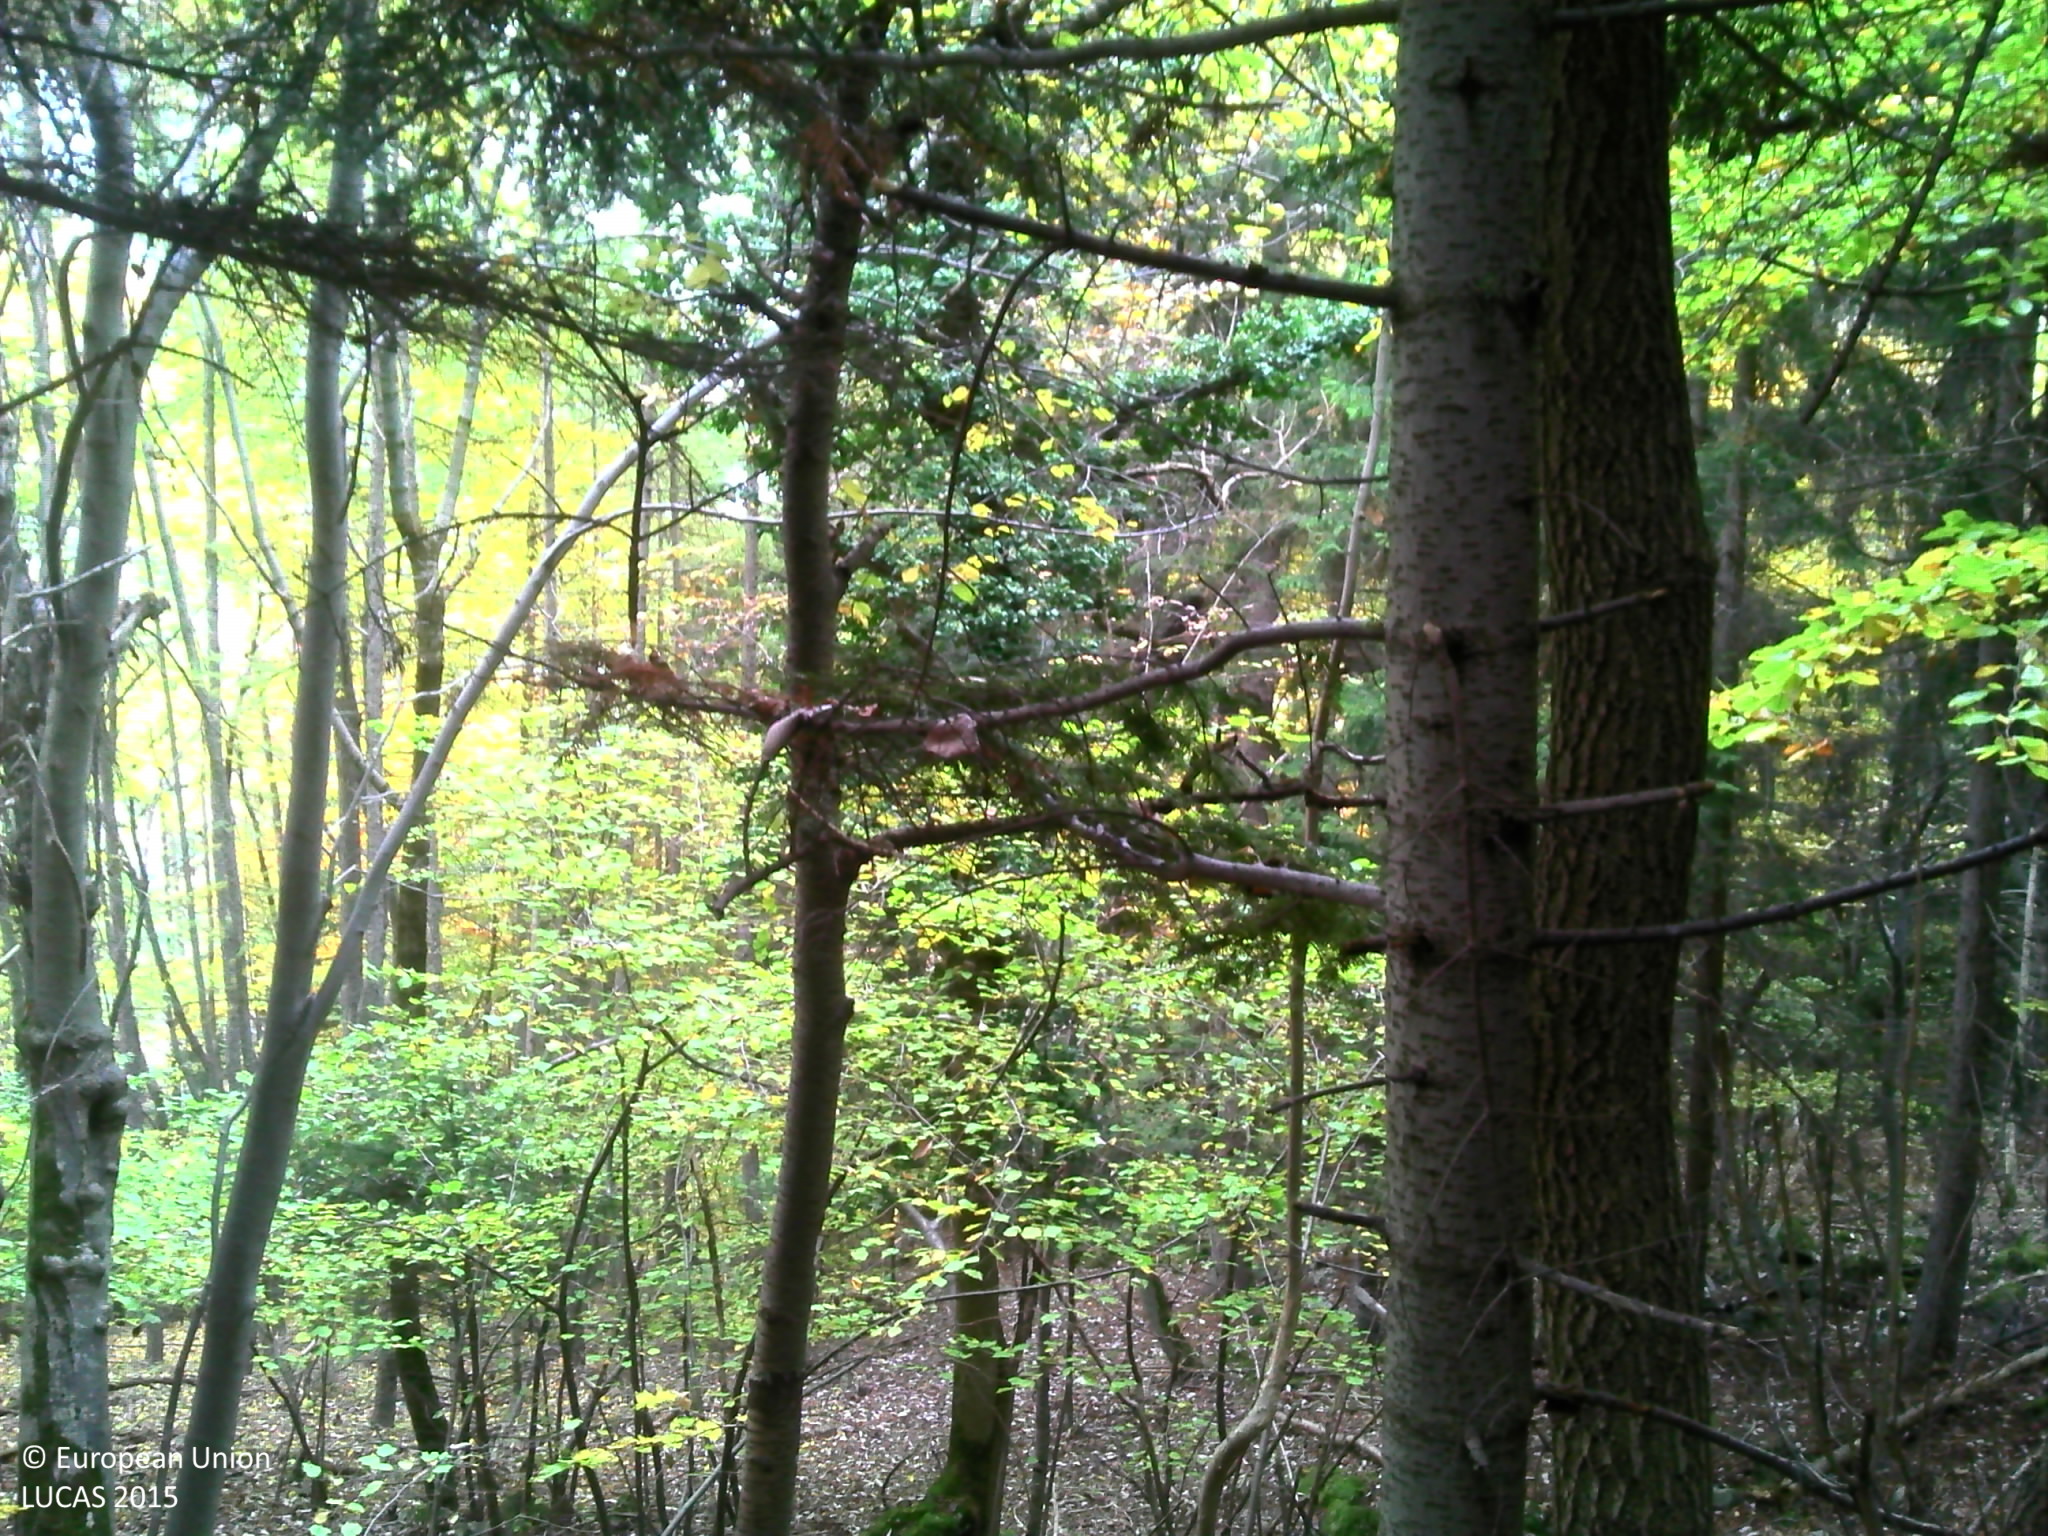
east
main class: Woodland
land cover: Spruce dominated mixed woodland
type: hemiboreal forest and nemoral coniferous forest and mixed broadleaved-coniferous forest
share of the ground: > 75 %
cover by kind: coniferous forest trees 50 %, broadleaved forest trees 40 %, unconsolidated bare surface 10 %
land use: Forestry
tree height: > 5 m
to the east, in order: Spruce dominated mixed woodland; Tracks; Spruce dominated mixed woodland; Broadleaved woodland; Dry stone walls; Broadleaved woodland; Dry stone walls; Paved roads, cycling and walking lanes; Grassland without tree/shrub cover; Paved roads, cycling and walking lanes; Broadleaved woodland; Tracks; Broadleaved woodland
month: October
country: FR
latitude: 45.2103
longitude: 6.4527
